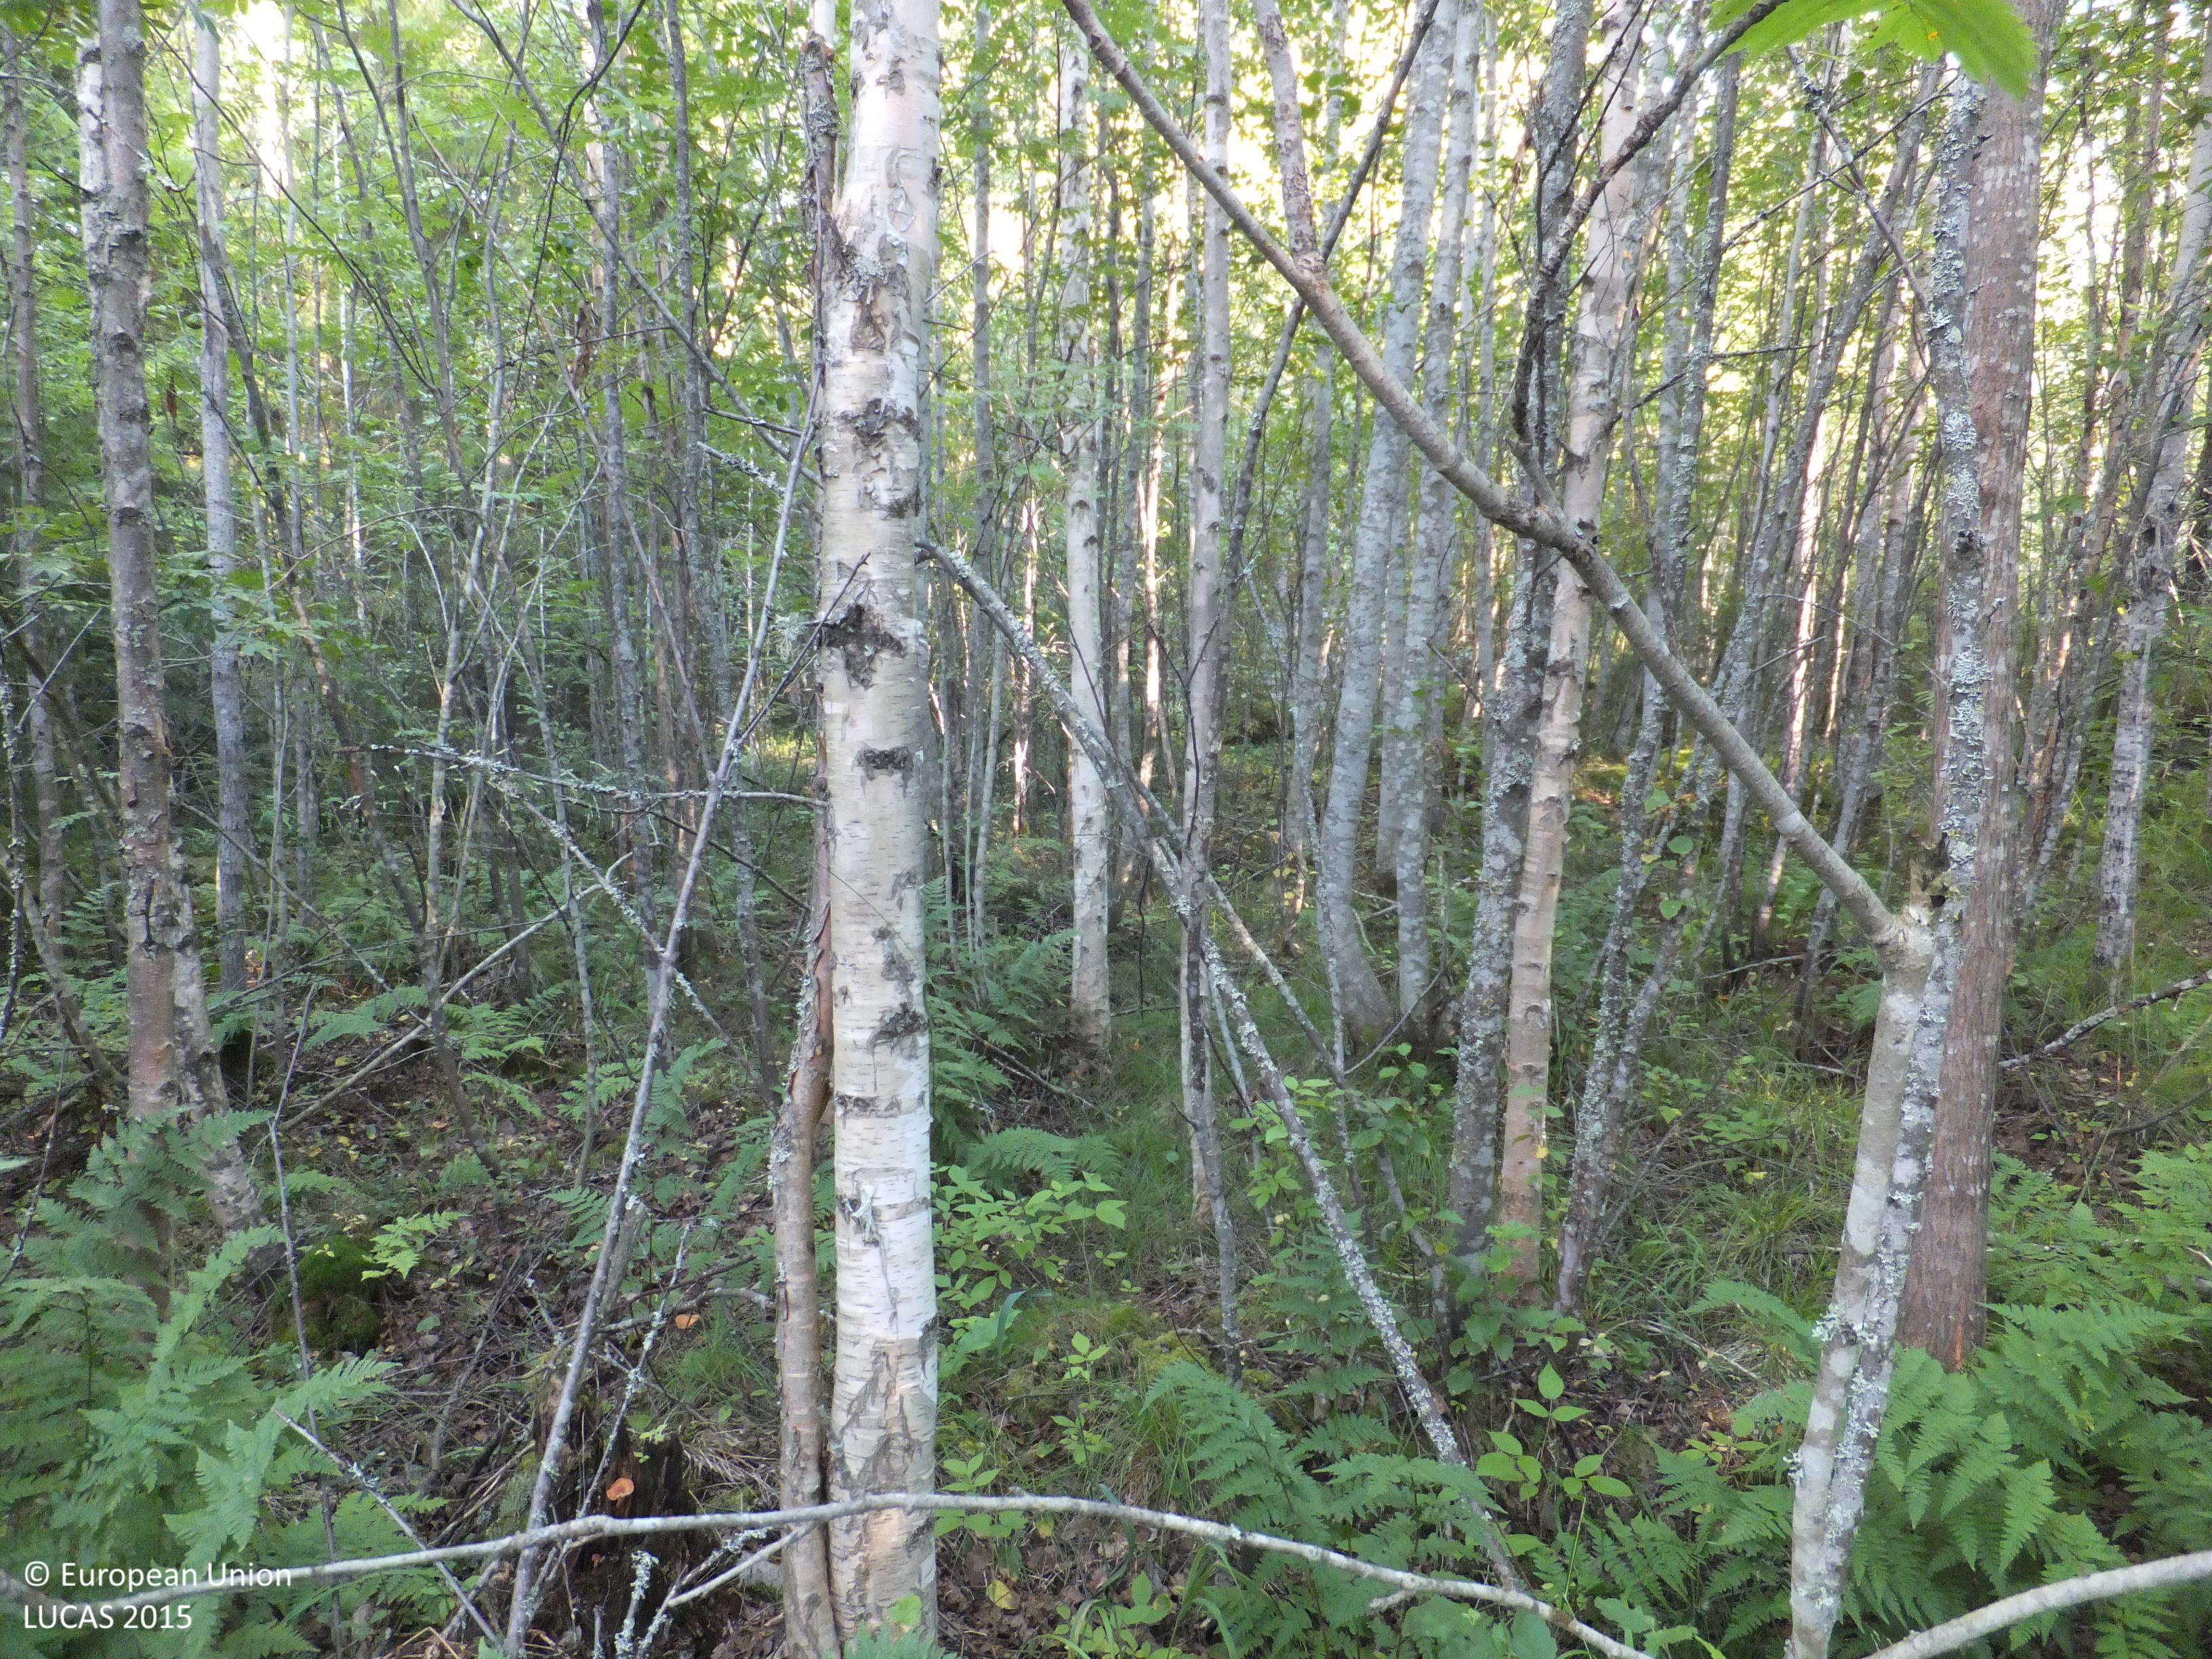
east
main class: Woodland
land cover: Broadleaved woodland
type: boreal forest
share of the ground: > 75 %
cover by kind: broadleaved forest trees 85 %, herbaceous plants 10 %, lichens and mosses 5 %
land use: Forestry
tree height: > 5 m
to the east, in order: Broadleaved woodland; Spruce dominated mixed woodland; Other mixed woodland; Spruce dominated coniferous woodland; Spruce dominated mixed woodland
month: August
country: FI
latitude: 63.1142
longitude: 22.7193
